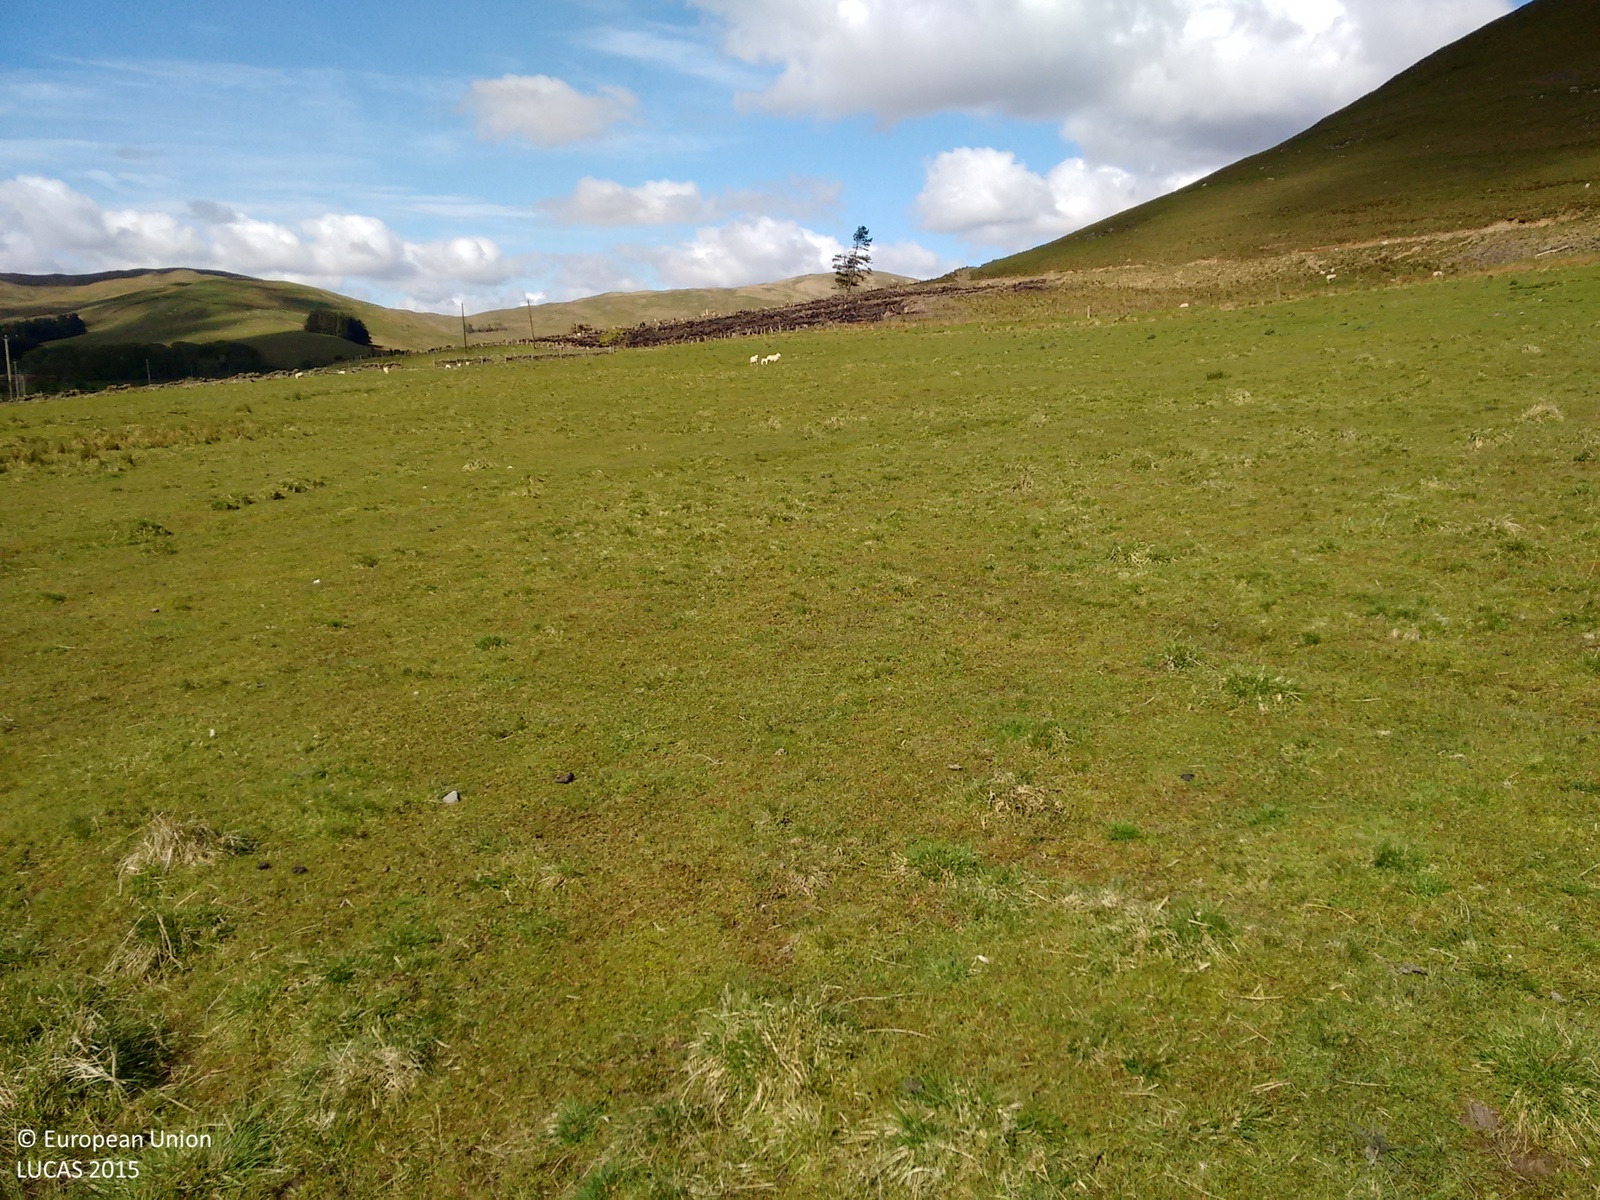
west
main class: Grassland
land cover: Grassland without tree/shrub cover
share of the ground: > 75 %
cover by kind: herbaceous plants 95 %, shrubs 5 %
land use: Agriculture (excluding fallow land and kitchen gardens)
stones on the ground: < 10 %
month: May
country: GB
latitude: 55.4591
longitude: -3.0865
